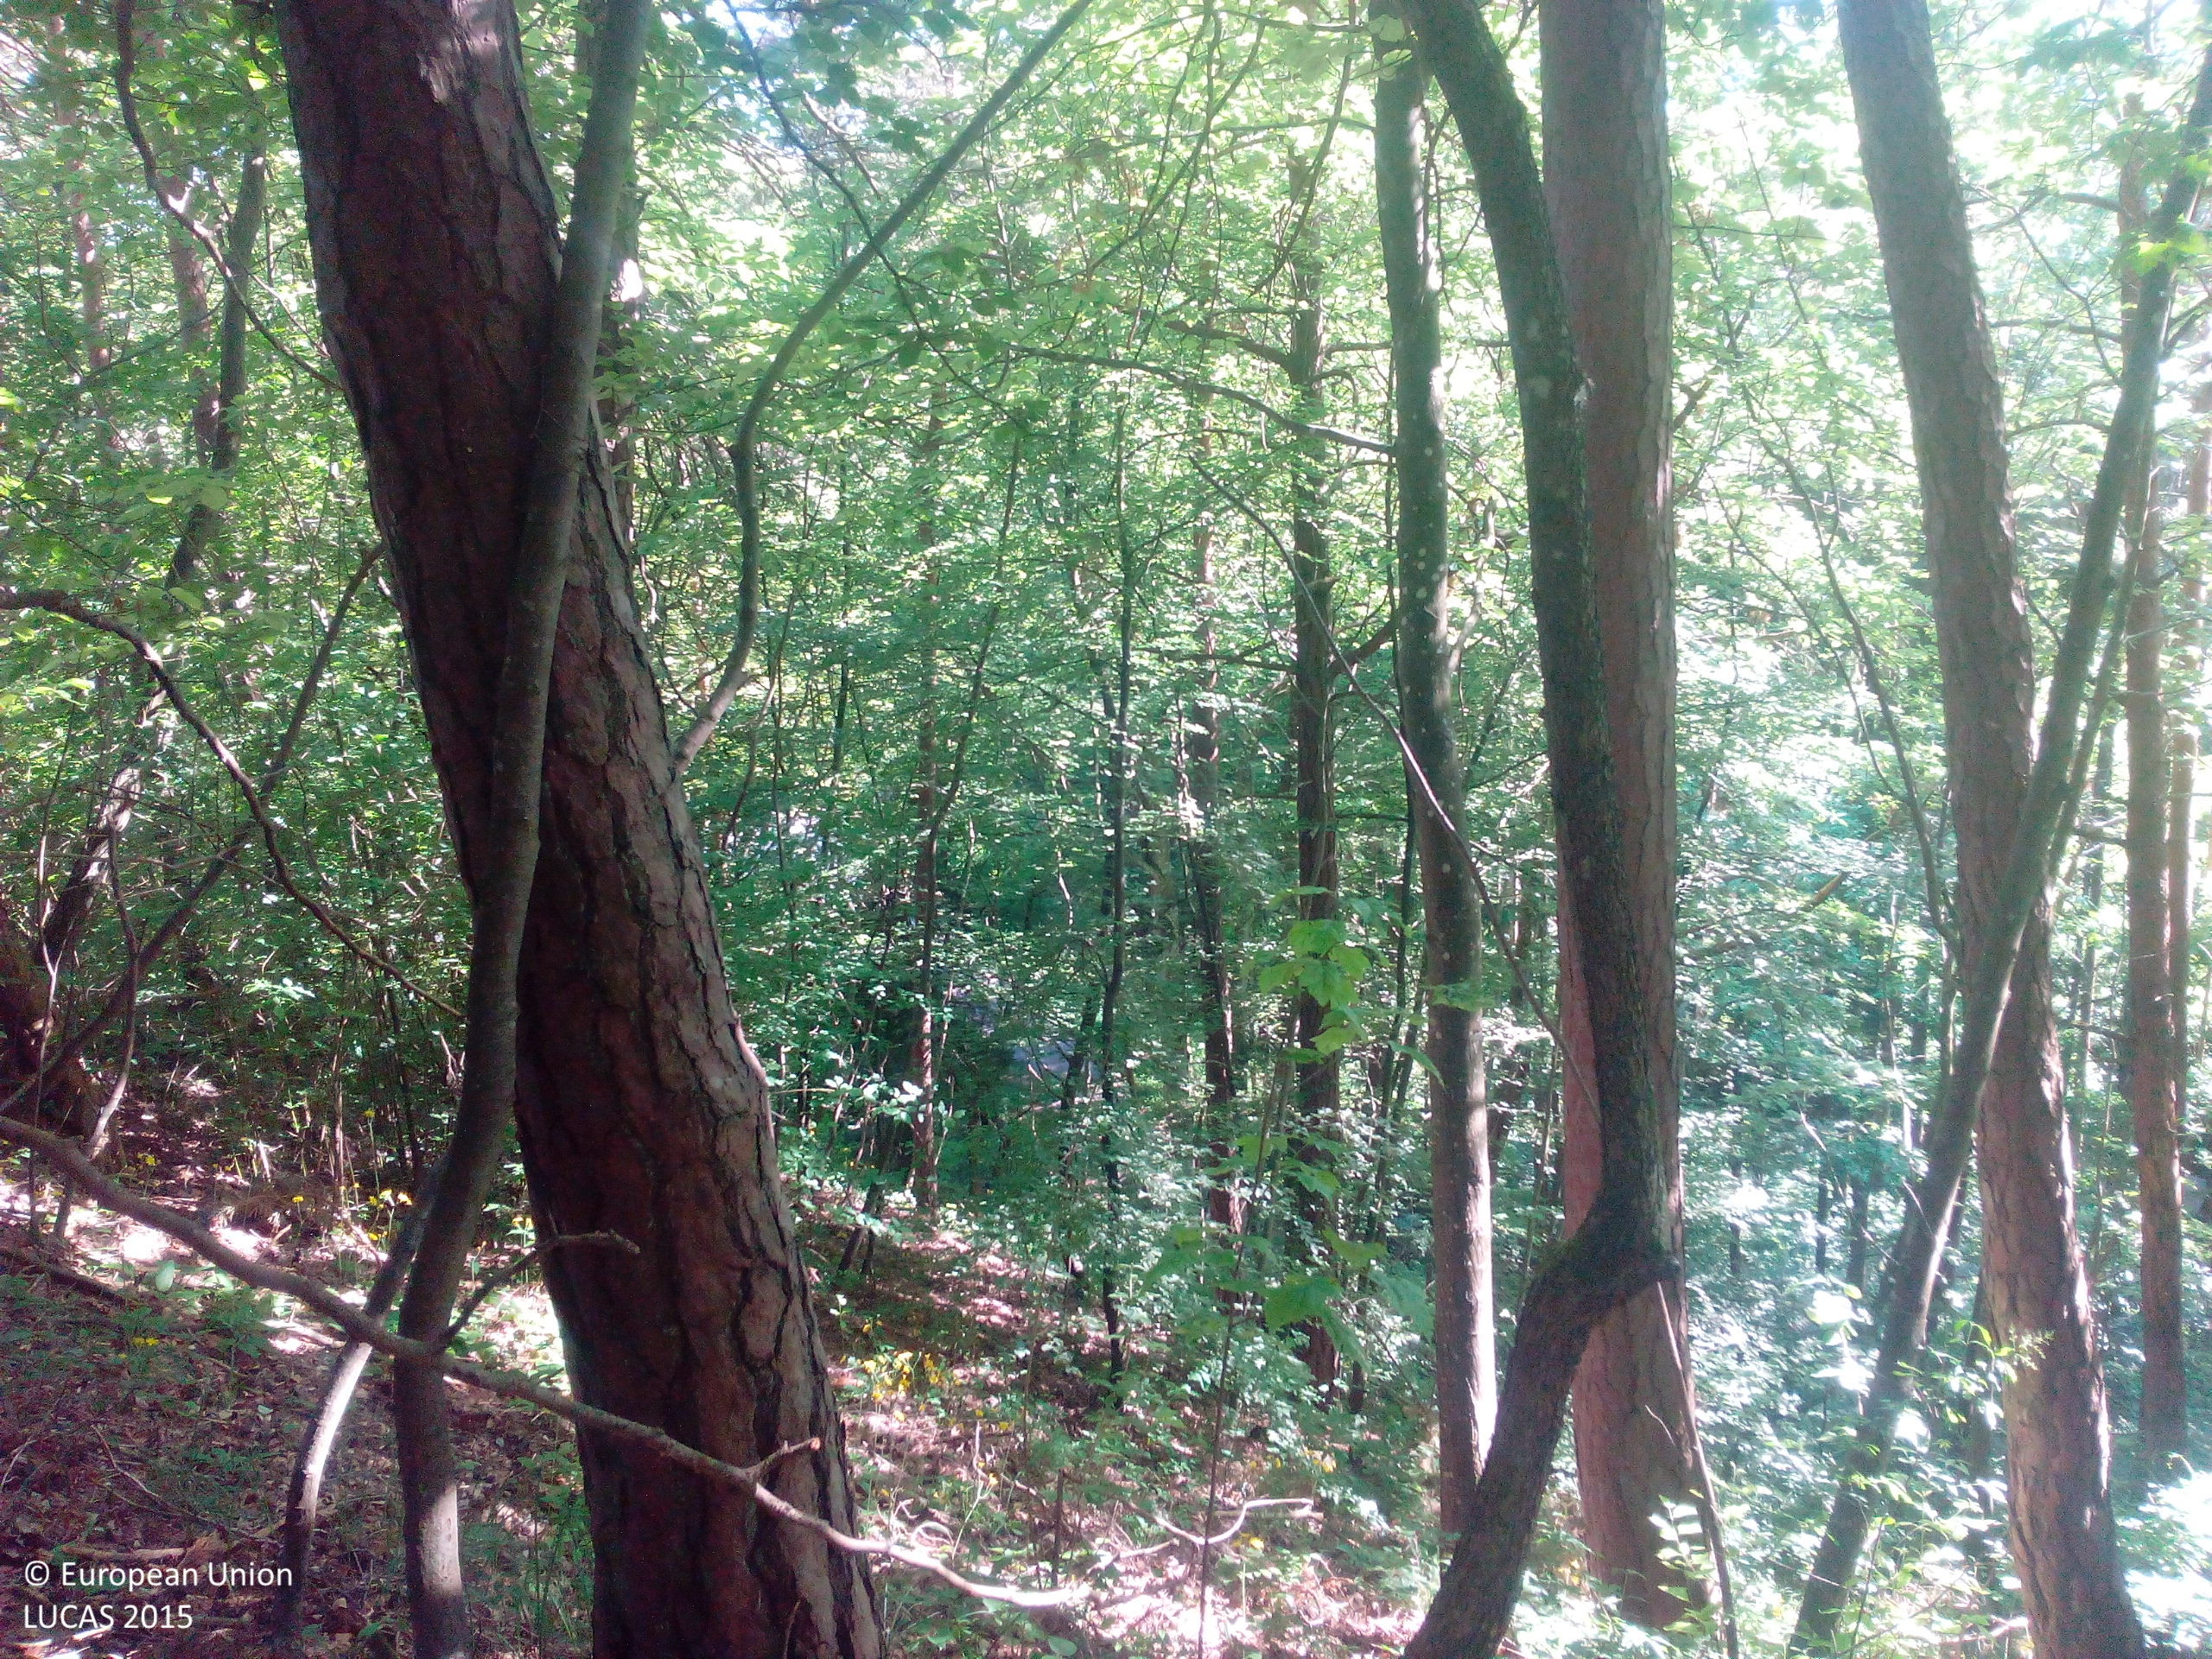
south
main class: Woodland
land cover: Pine dominated mixed woodland
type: beech forest
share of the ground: > 75 %
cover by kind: broadleaved forest trees 70 %, coniferous forest trees 25 %, unconsolidated bare surface 5 %
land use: Forestry
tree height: > 5 m
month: June
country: DE
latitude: 47.8743
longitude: 8.7307
